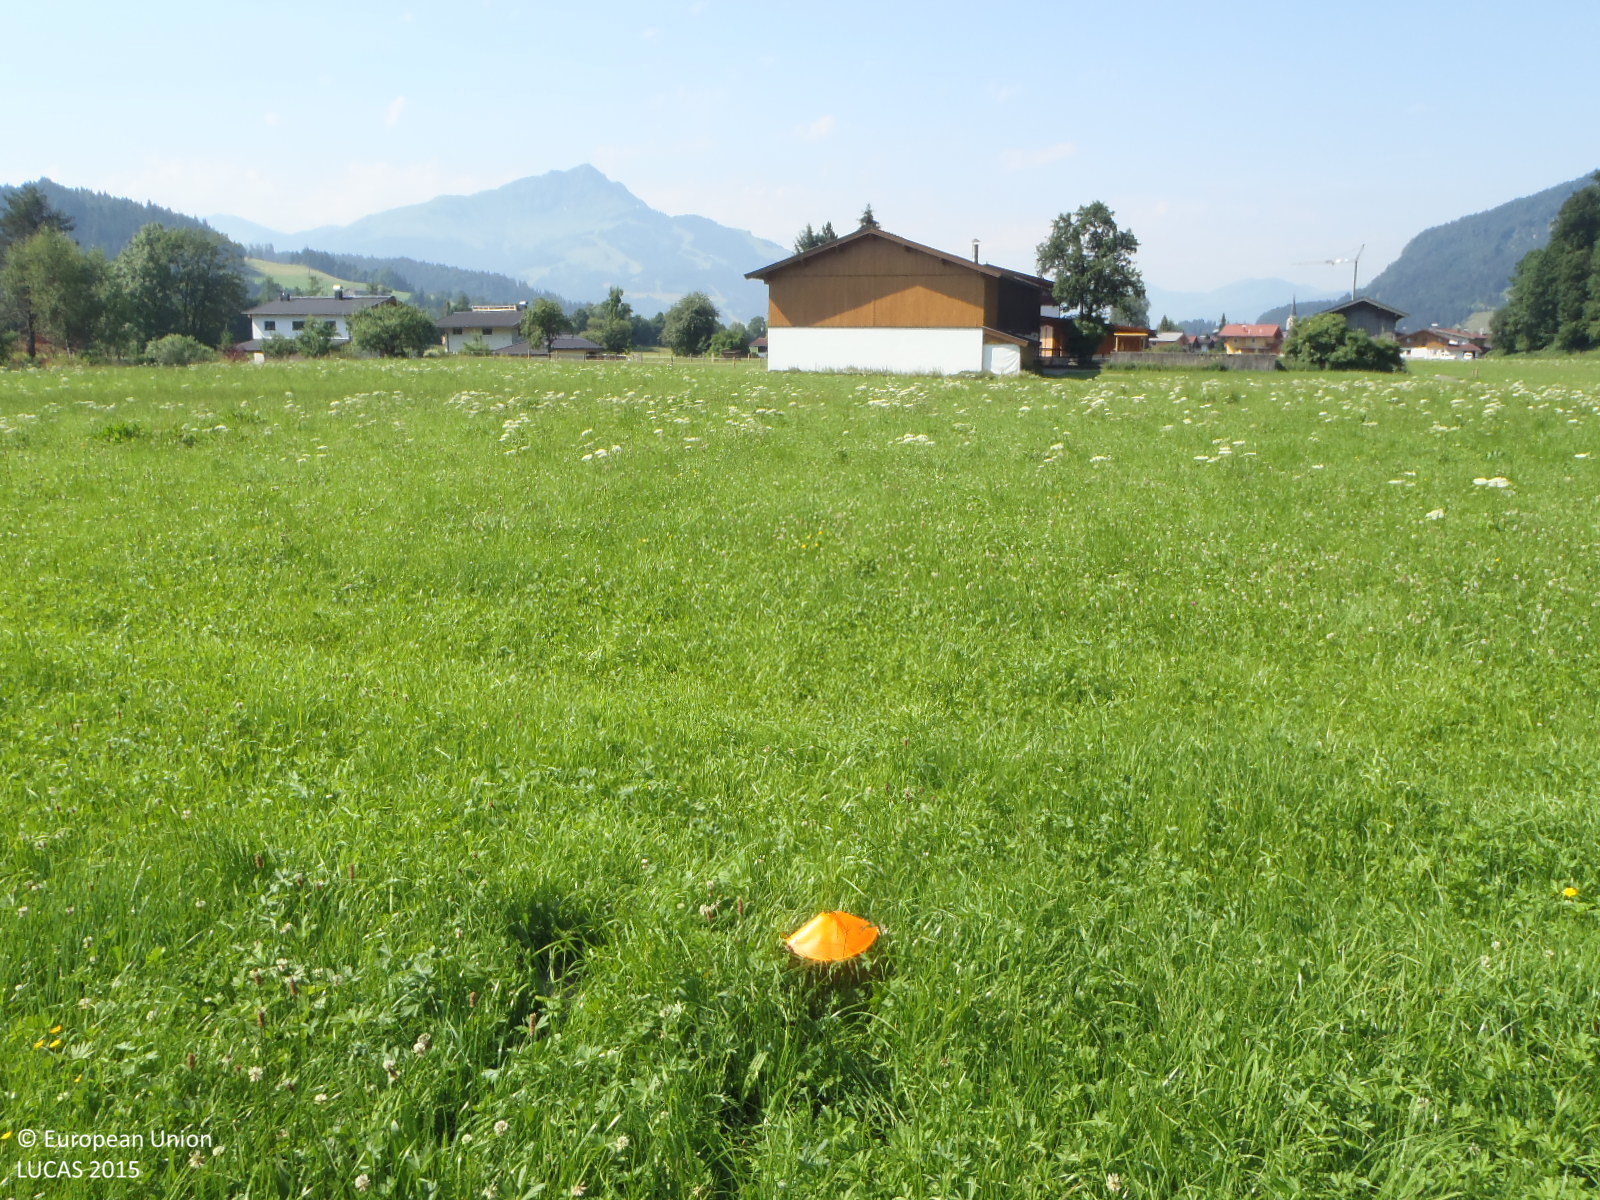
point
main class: Grassland
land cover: Grassland without tree/shrub cover
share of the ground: > 75 %
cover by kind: herbaceous plants 100 %
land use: Agriculture (excluding fallow land and kitchen gardens)
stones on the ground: < 10 %
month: July
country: AT
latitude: 47.5660
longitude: 12.4574
